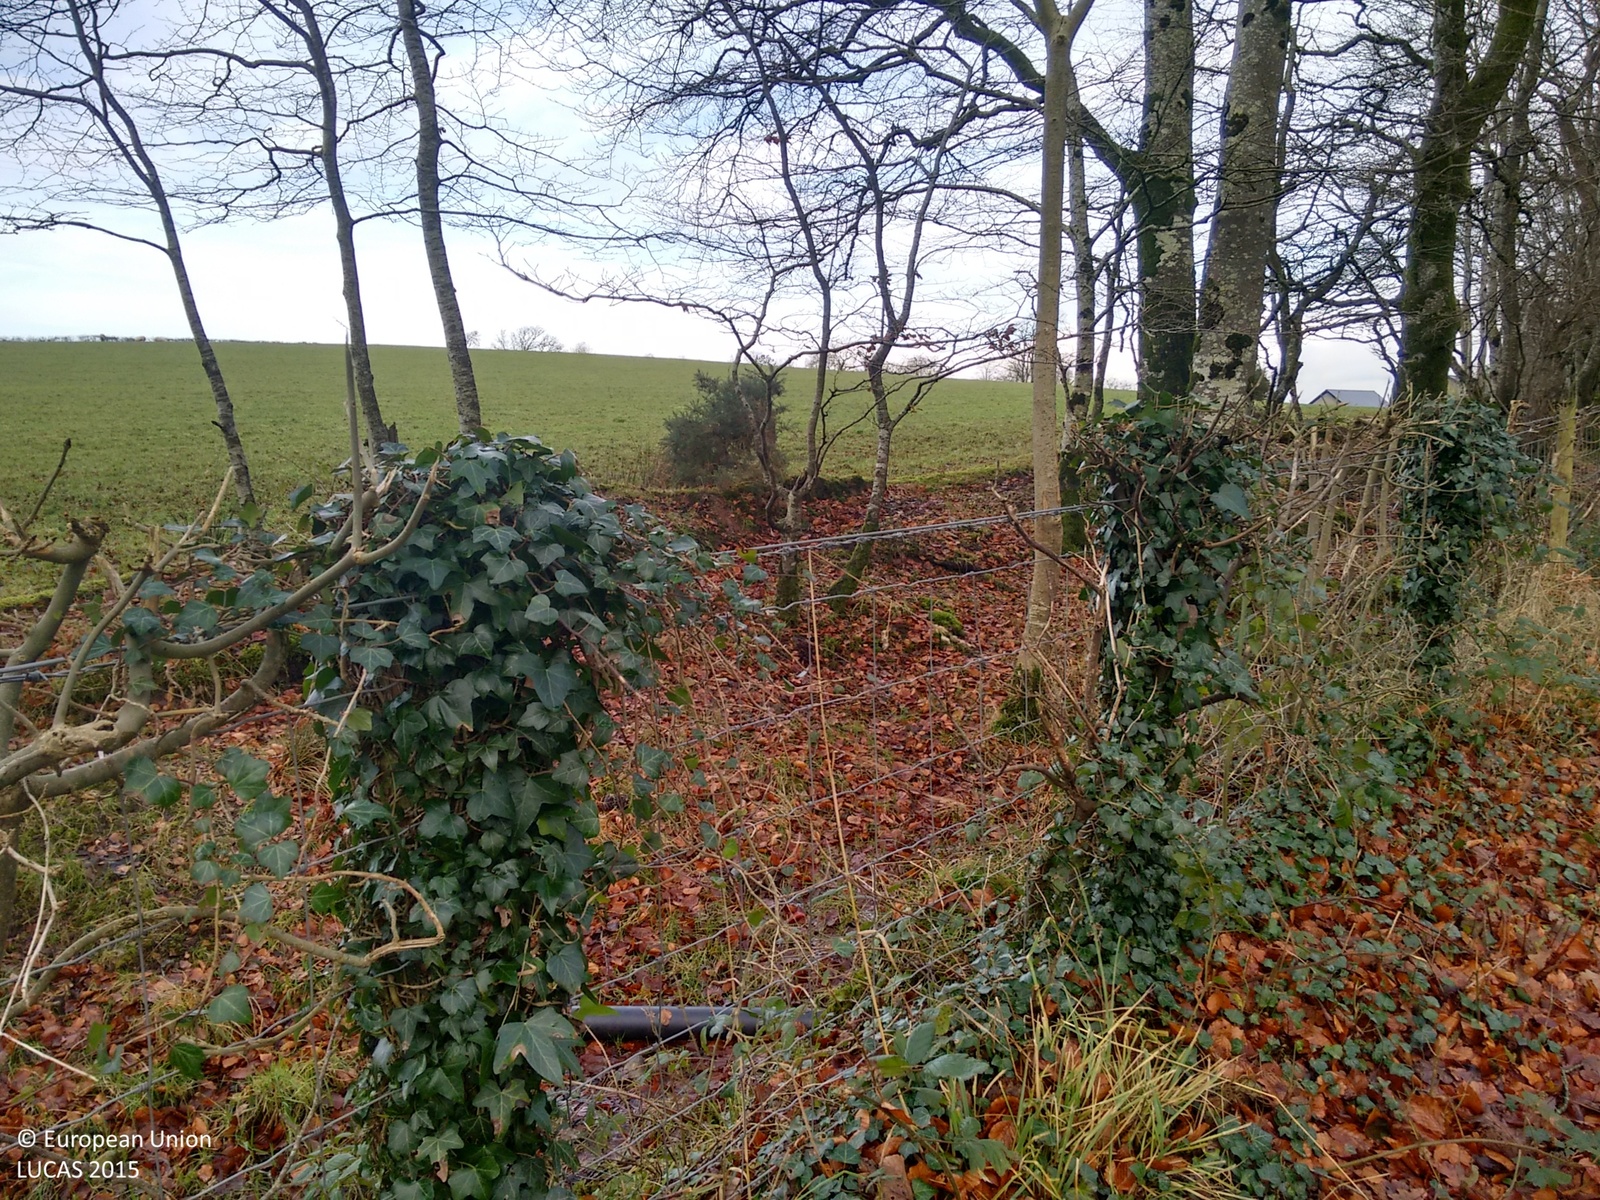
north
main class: Grassland
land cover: Grassland without tree/shrub cover
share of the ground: > 75 %
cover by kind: herbaceous plants 100 %
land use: Agriculture (excluding fallow land and kitchen gardens)
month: December
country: GB
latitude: 54.5654
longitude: -7.3649
